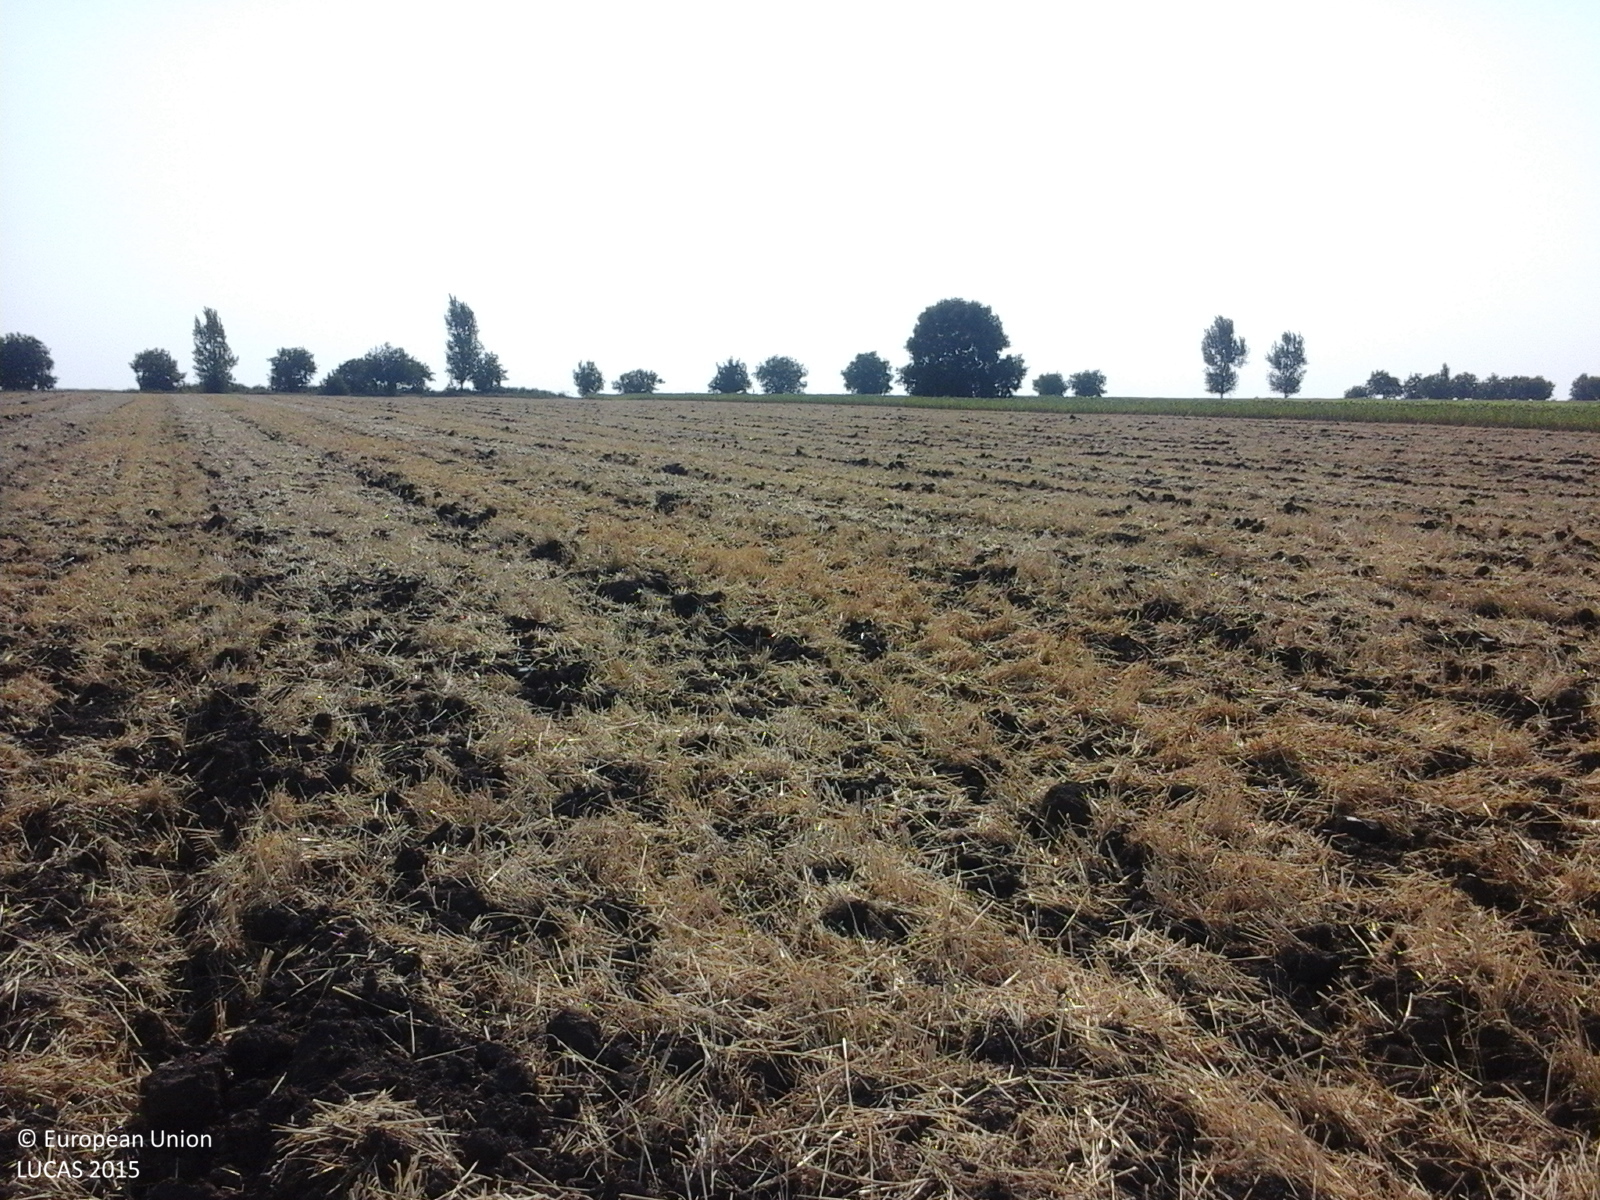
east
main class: Cropland
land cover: Common wheat
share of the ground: 10 - 25 %
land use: Agriculture (excluding fallow land and kitchen gardens)
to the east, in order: Common wheat; Sunflower
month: July
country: RO
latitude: 45.7696
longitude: 27.8747
